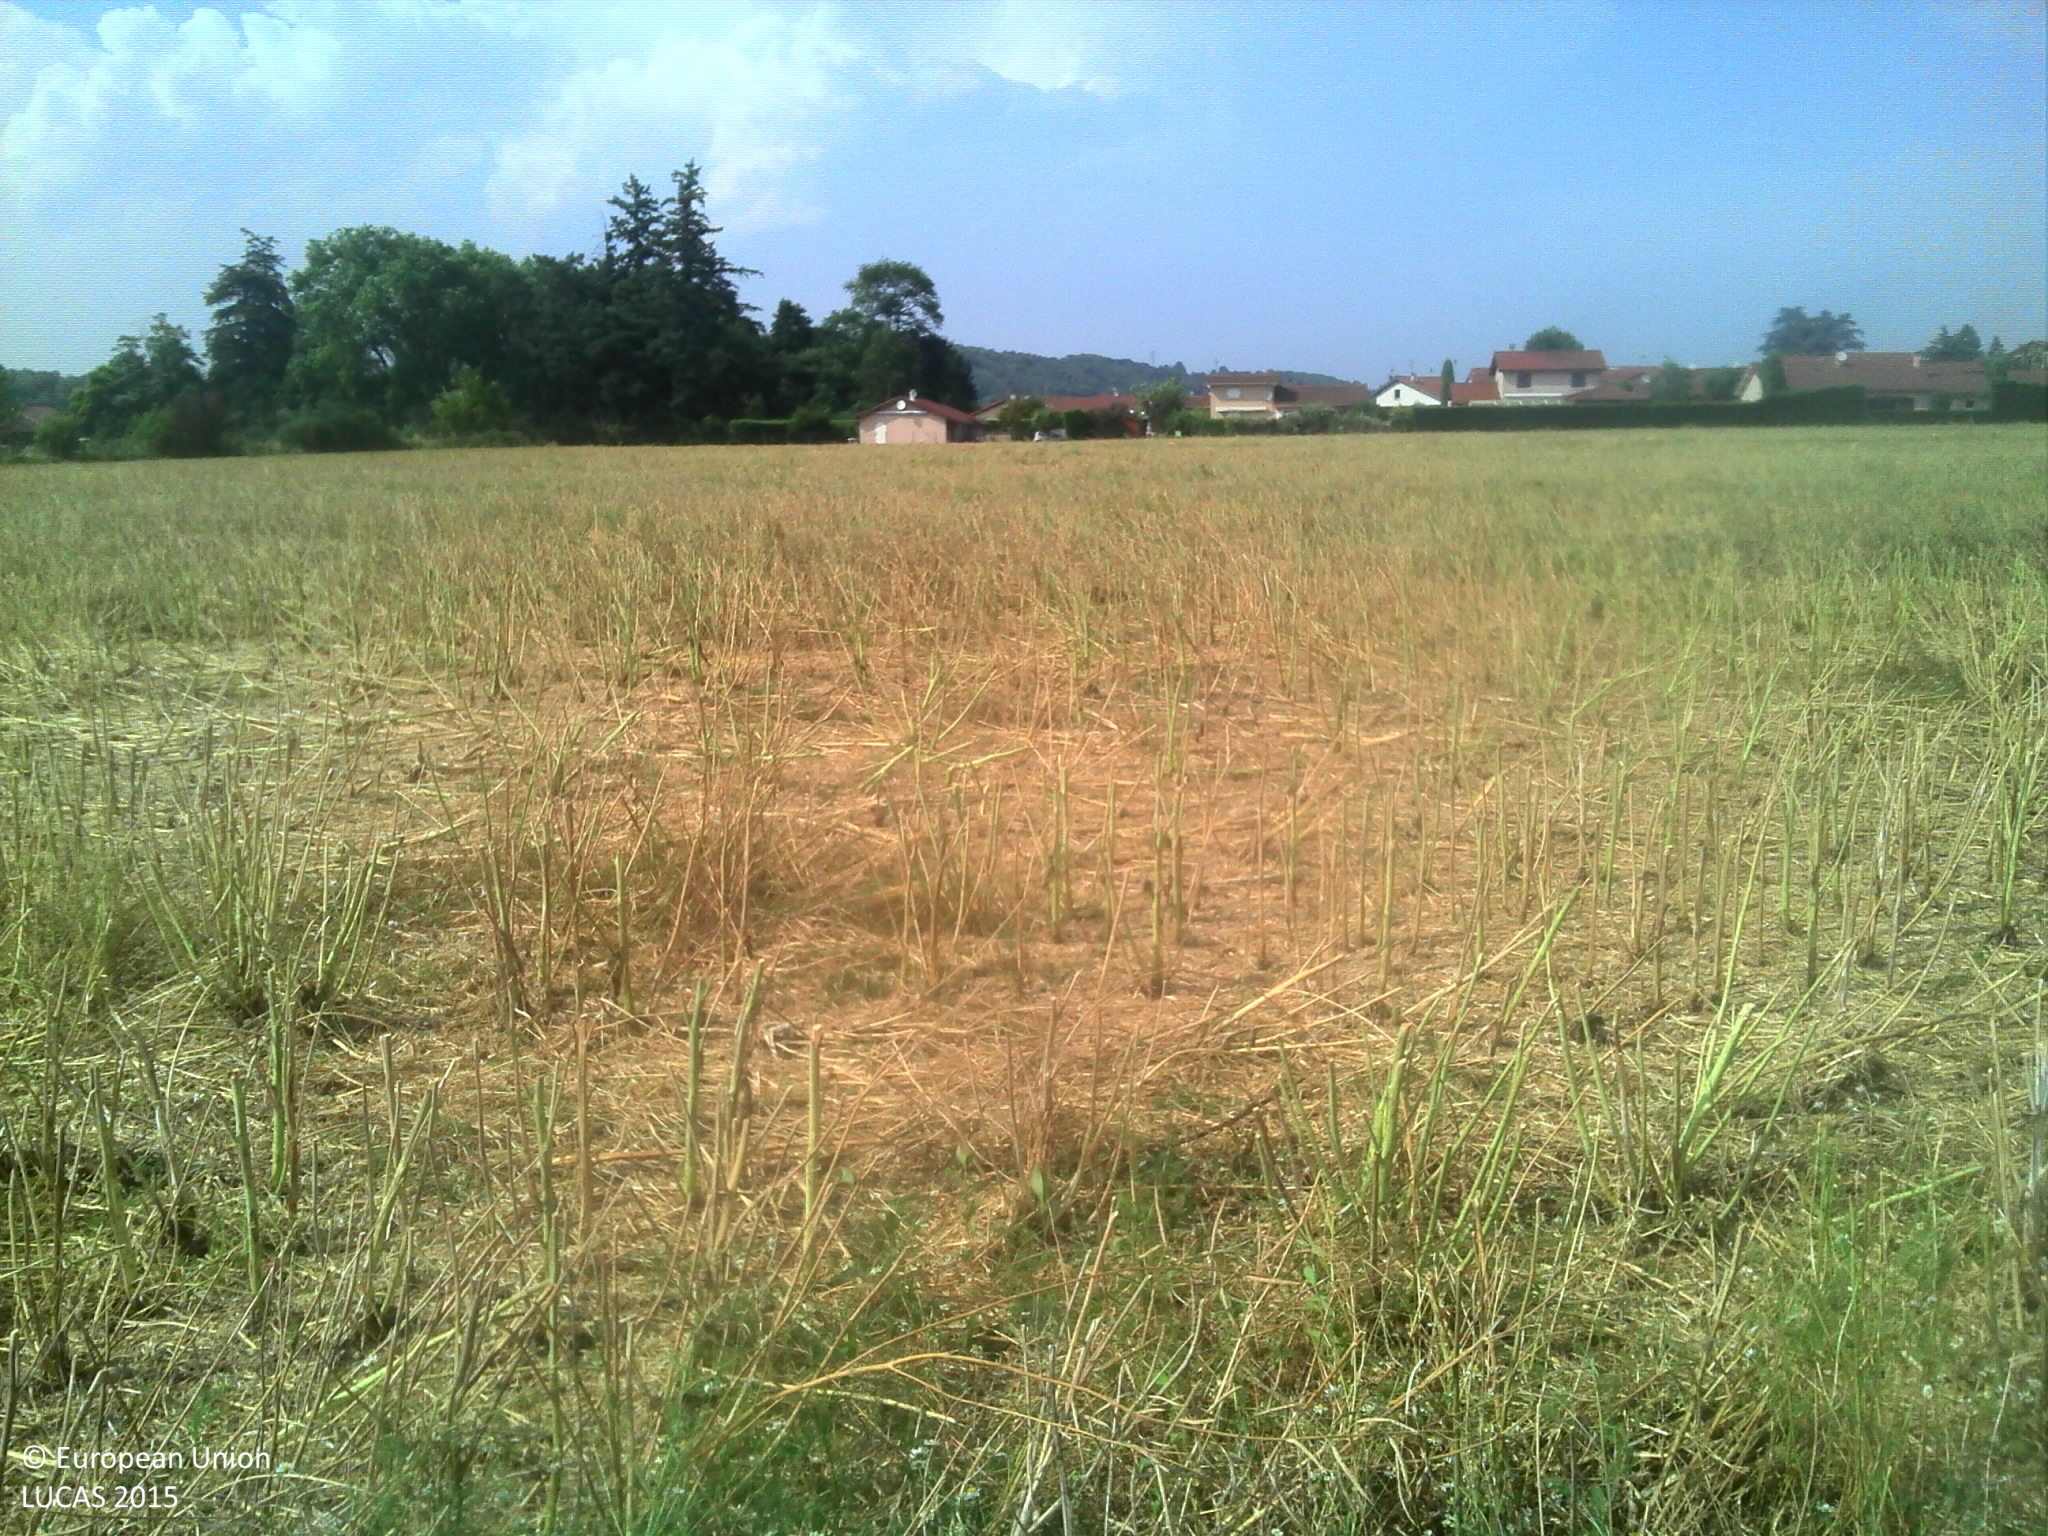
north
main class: Cropland
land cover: Rape and turnip rape
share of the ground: > 75 %
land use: Agriculture (excluding fallow land and kitchen gardens)
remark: Harvested field
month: July
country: FR
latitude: 45.5159
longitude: 5.0759
